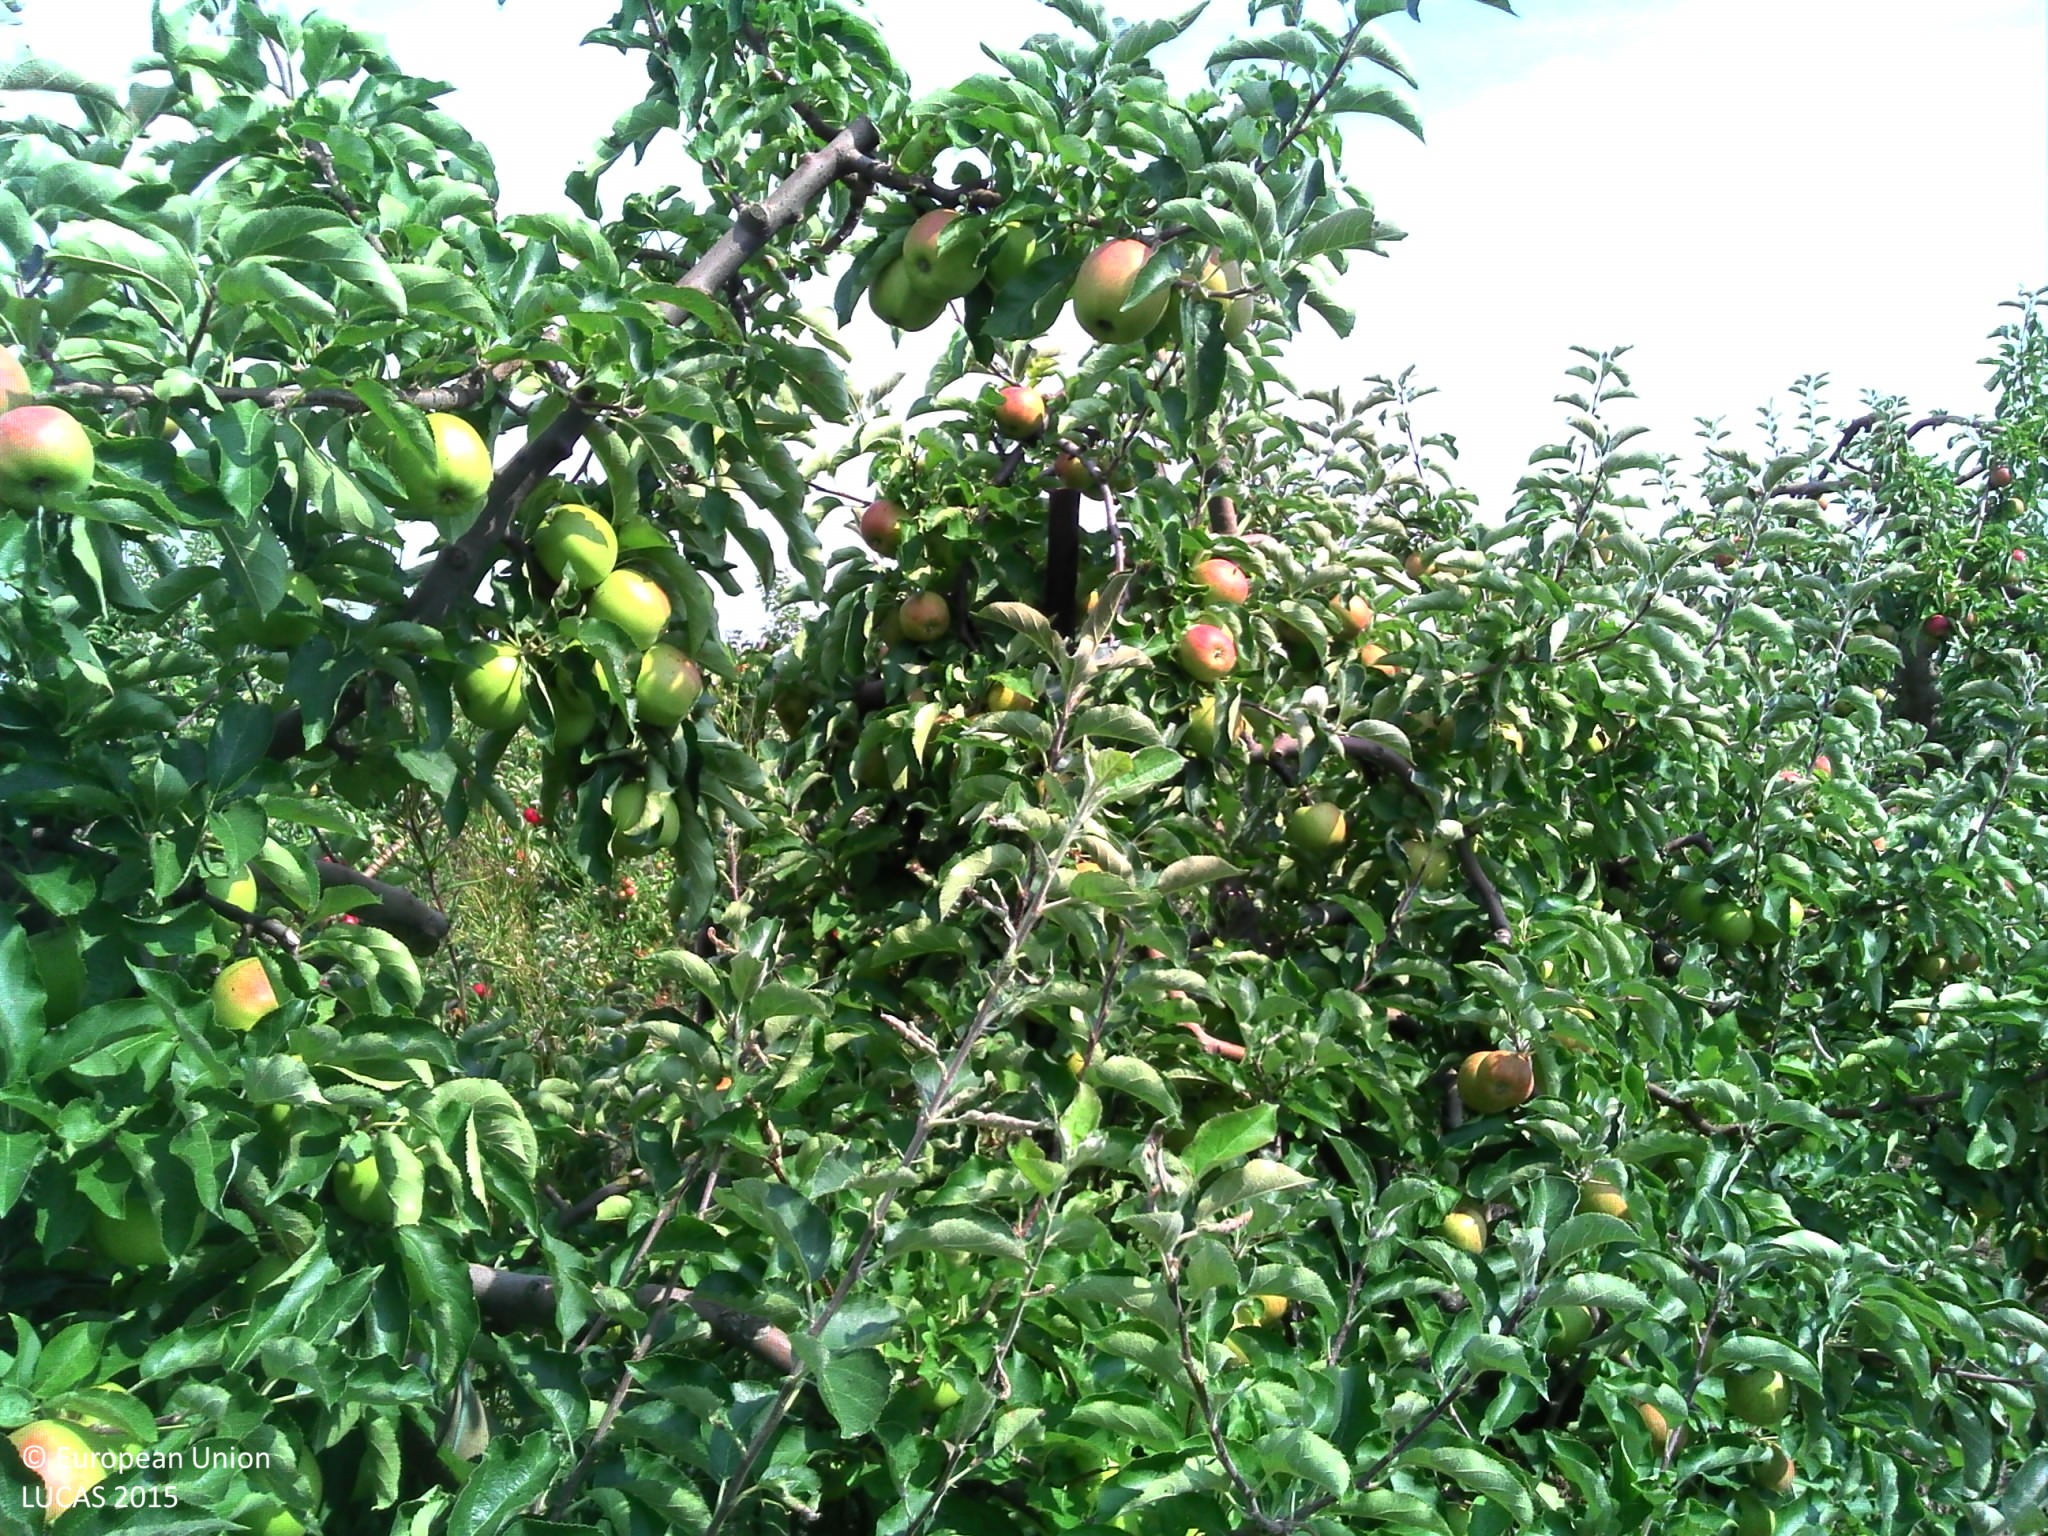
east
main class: Cropland
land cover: Apple fruit
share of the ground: 50 - 75 %
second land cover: Grassland without tree/shrub cover
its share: 25 - 50 %
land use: Agriculture (excluding fallow land and kitchen gardens)
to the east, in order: Apple fruit; Grassland without tree/shrub cover; Spontaneously vegetated surfaces; Maize; Grass margins; Tracks; Grass margins; Common wheat
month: August
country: FR
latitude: 50.2591
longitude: 3.6388
